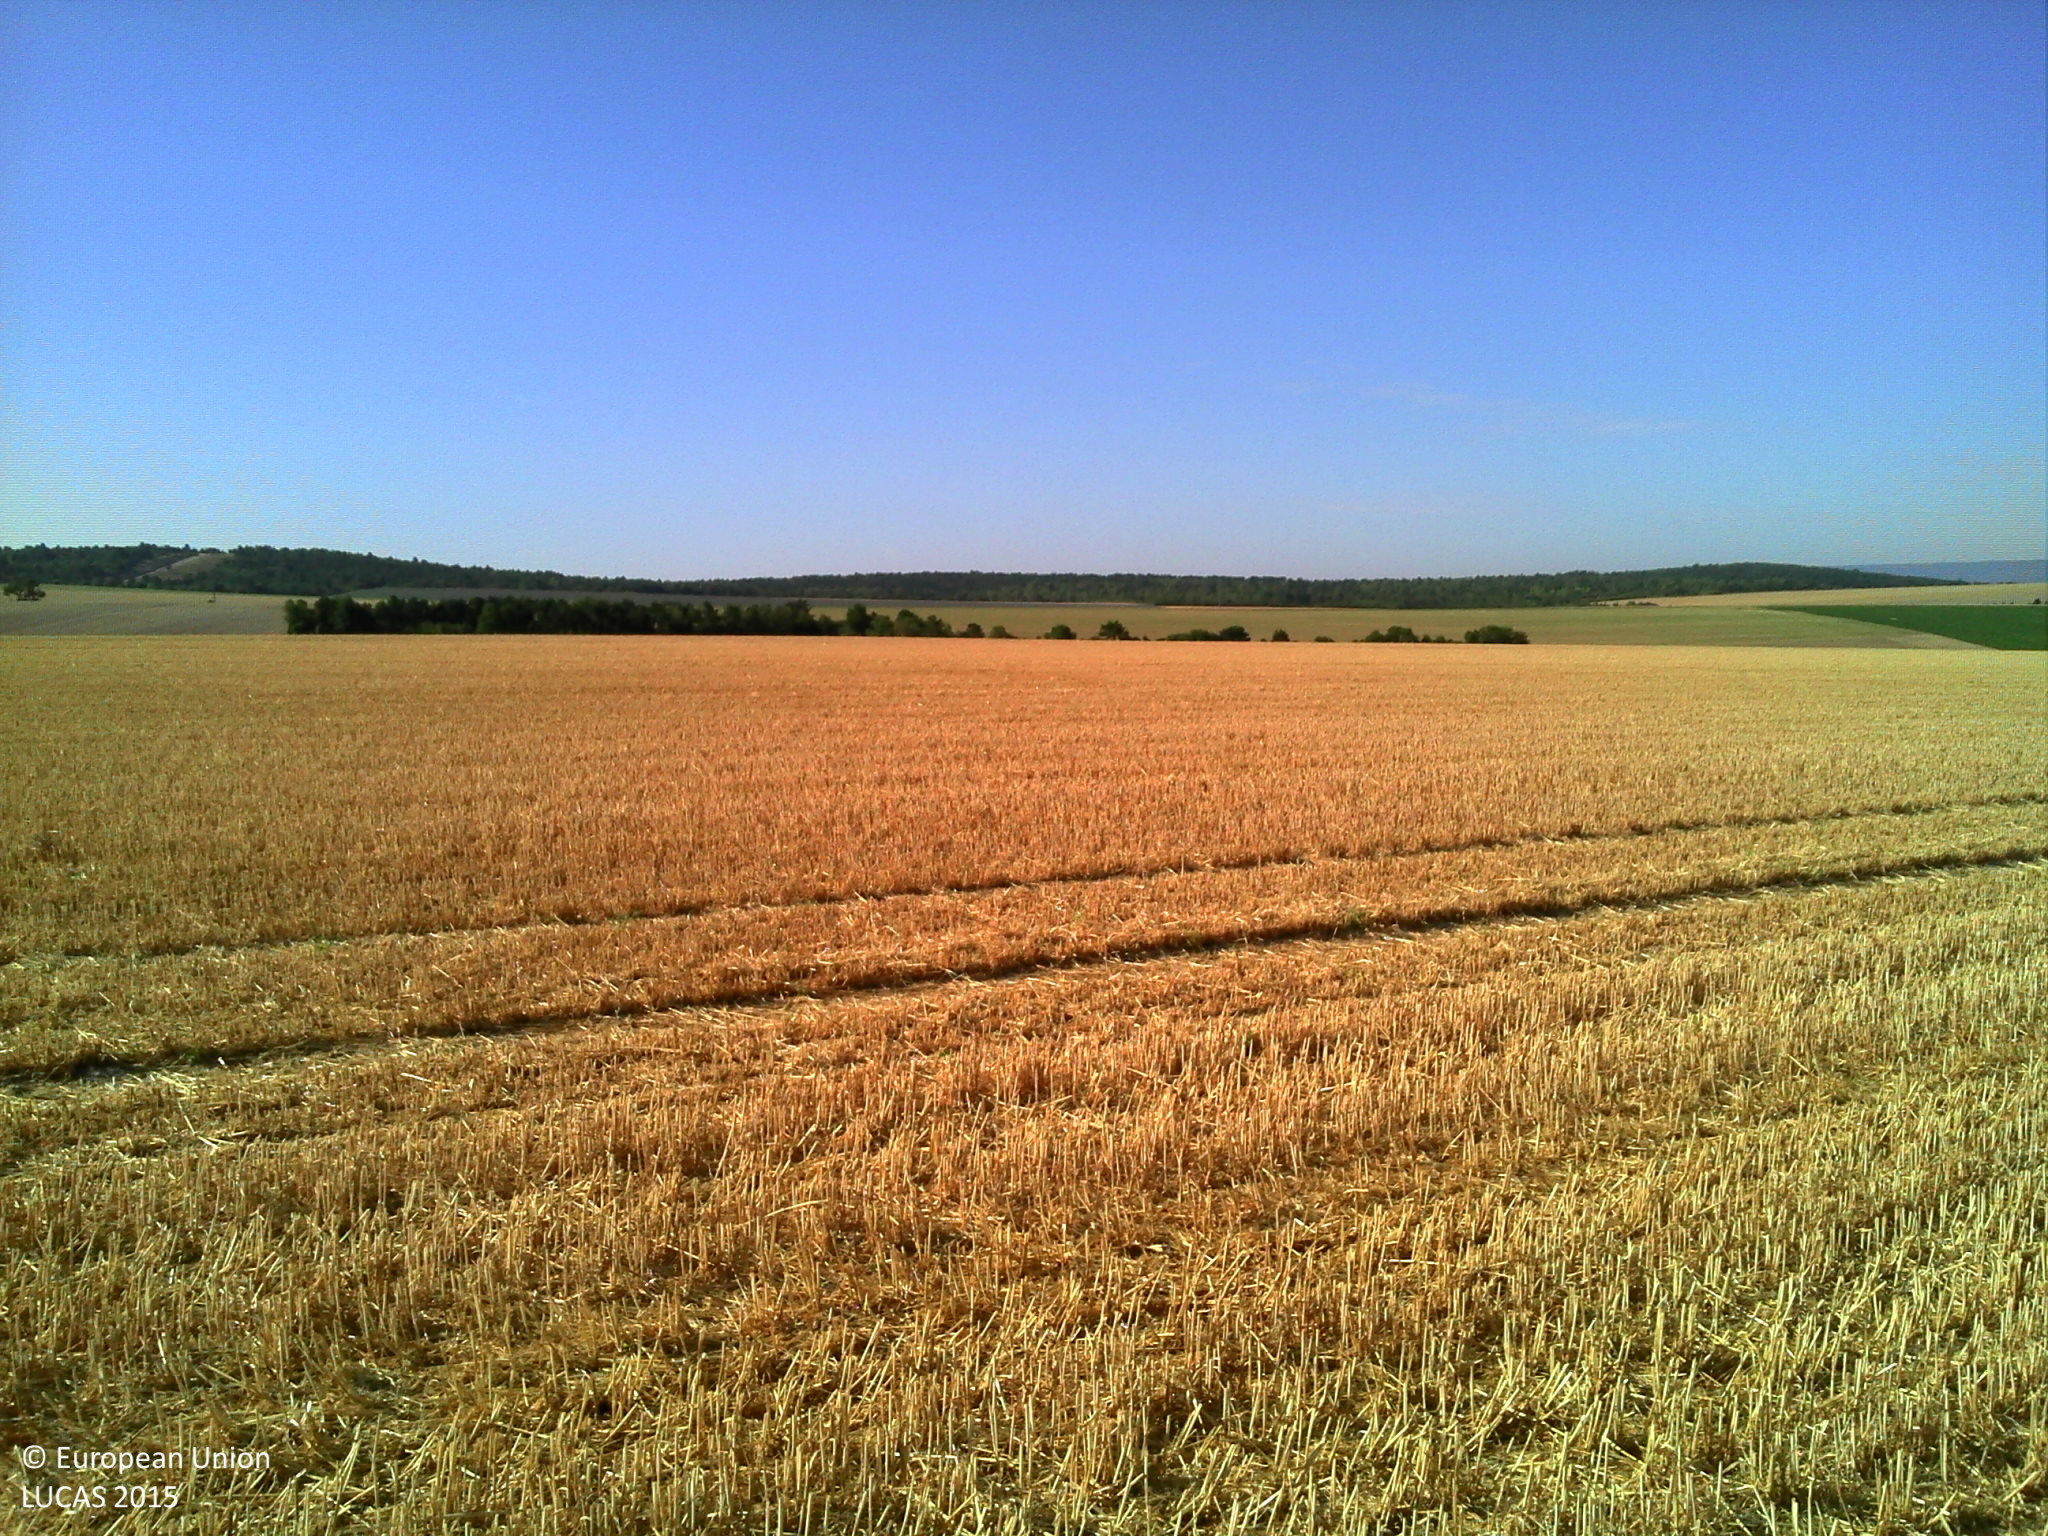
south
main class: Cropland
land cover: Common wheat
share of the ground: > 75 %
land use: Agriculture (excluding fallow land and kitchen gardens)
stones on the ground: < 10 %
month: August
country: FR
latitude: 49.2481
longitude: 4.2948
